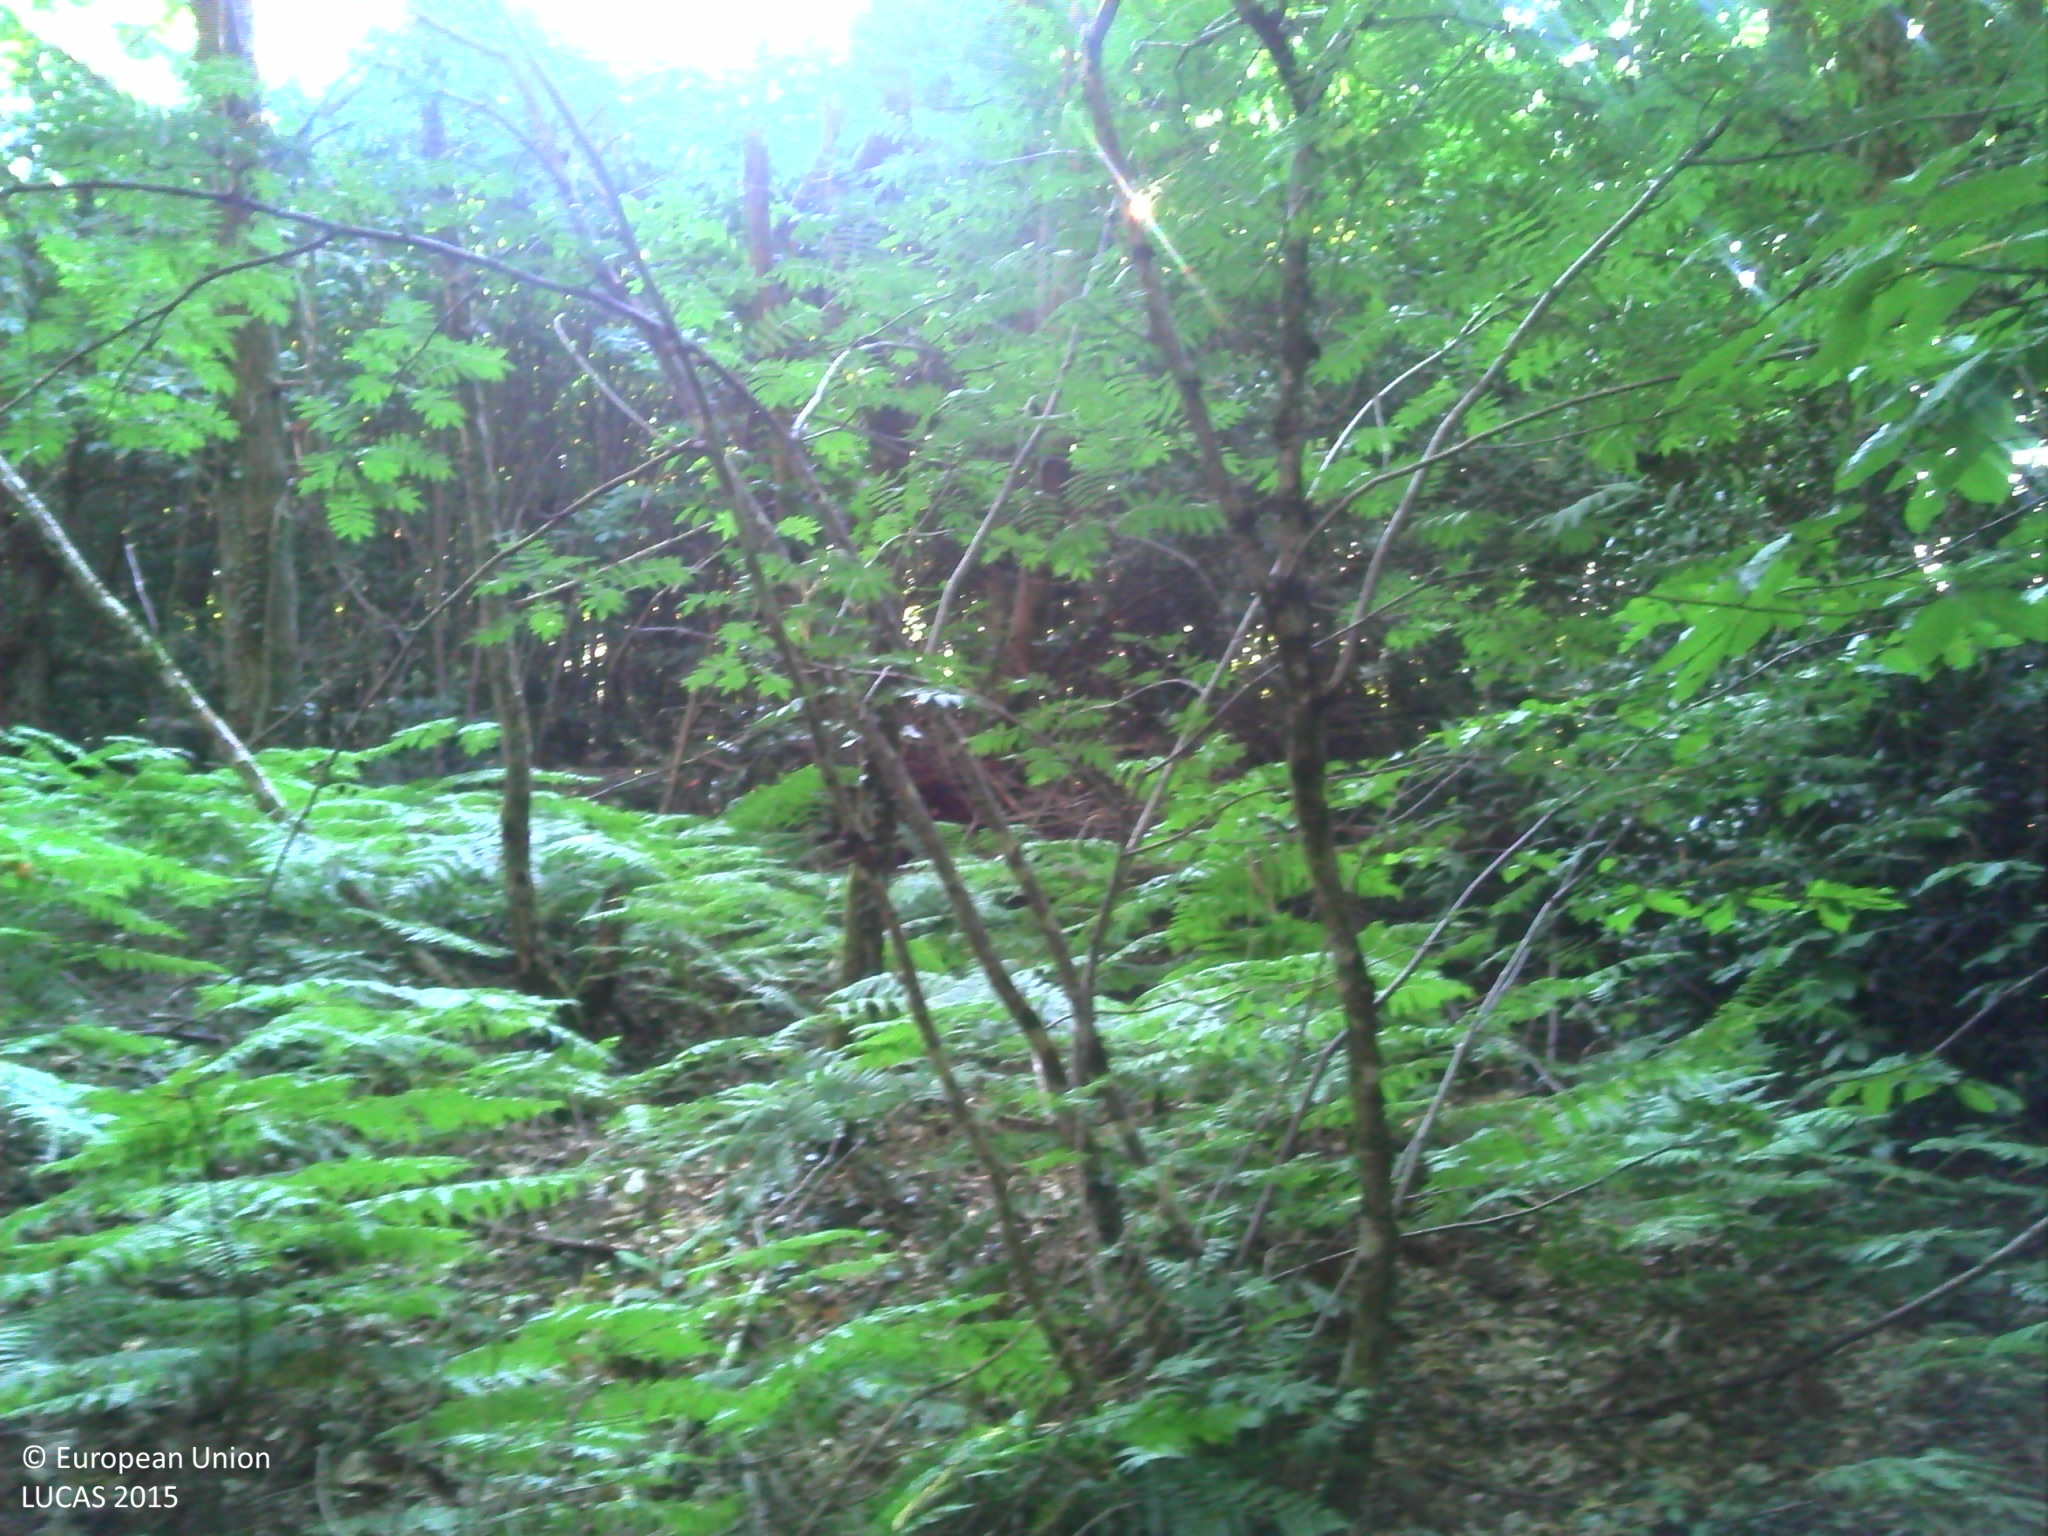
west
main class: Woodland
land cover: Broadleaved woodland
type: mesophytic deciduous forest
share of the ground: > 75 %
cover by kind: broadleaved forest trees 80 %, shrubs 10 %, herbaceous plants 10 %
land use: Forestry
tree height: > 5 m
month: July
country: FR
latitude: 46.2157
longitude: 1.5522
